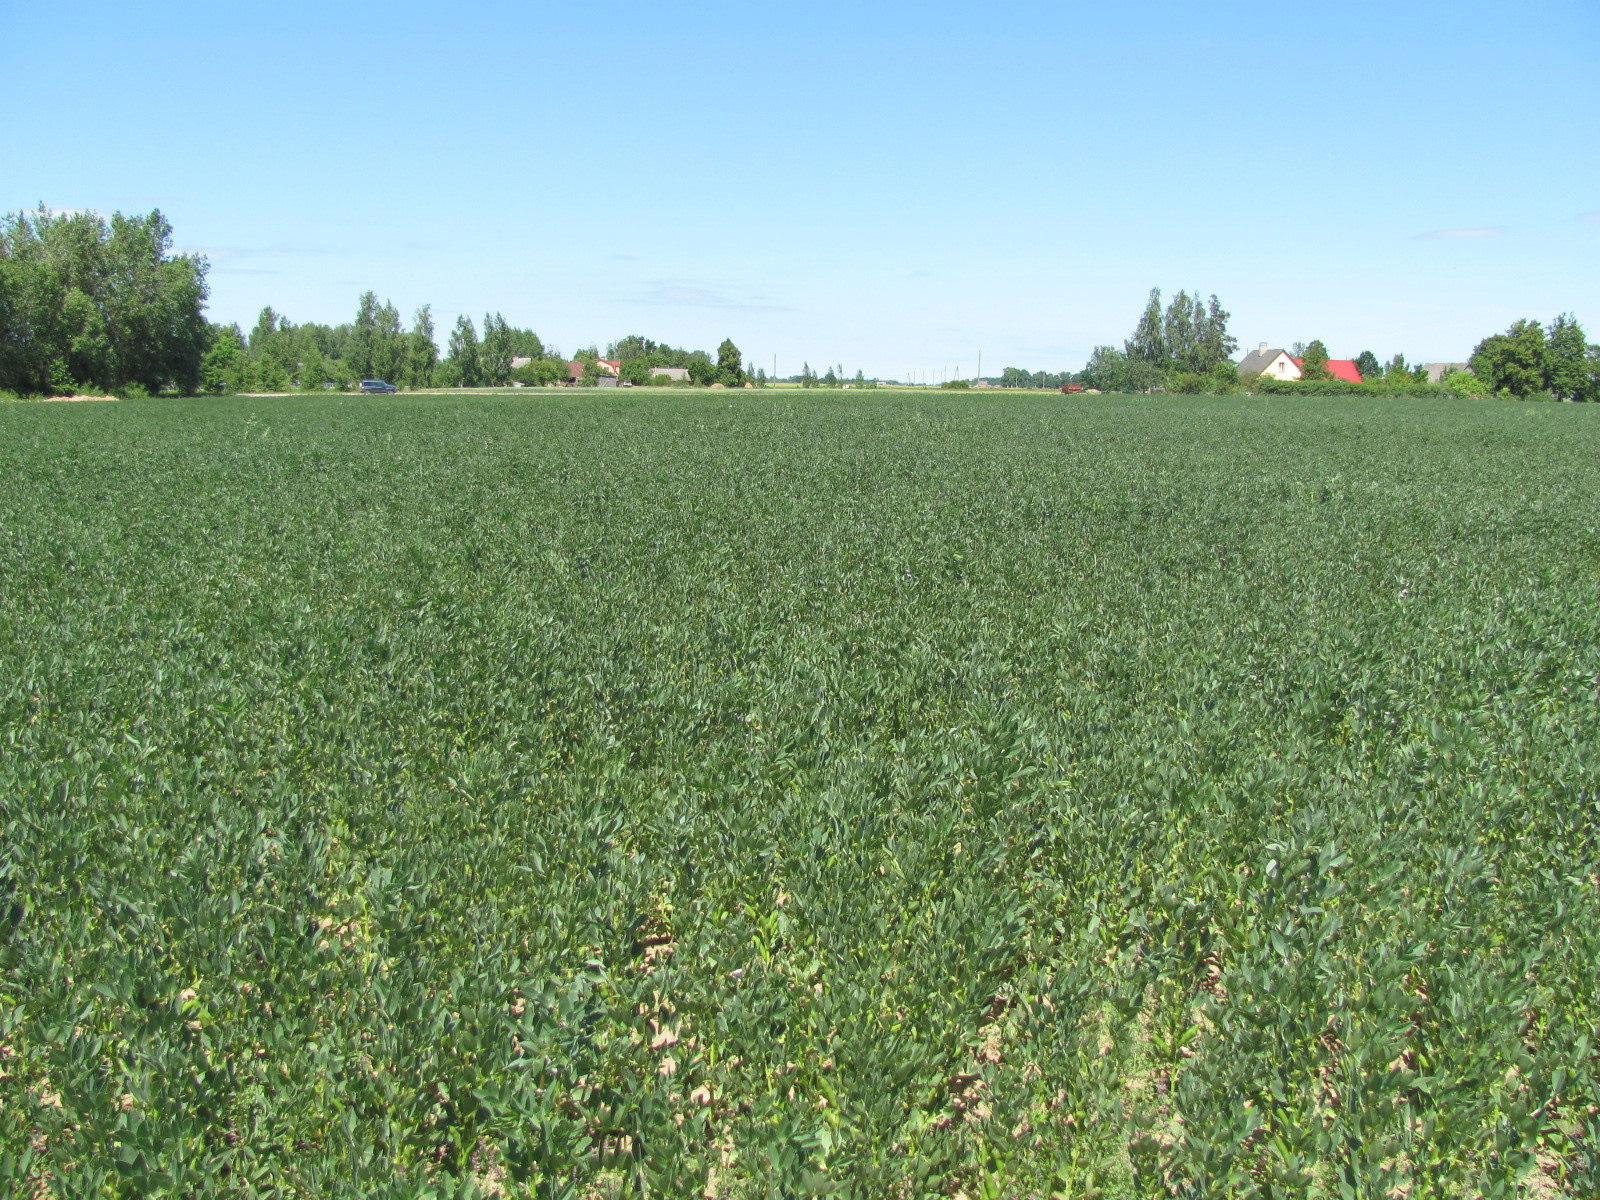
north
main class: Cropland
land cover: Dry pulses
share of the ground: > 75 %
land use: Agriculture (excluding fallow land and kitchen gardens)
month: July
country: LV
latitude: 56.4539
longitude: 23.6924
